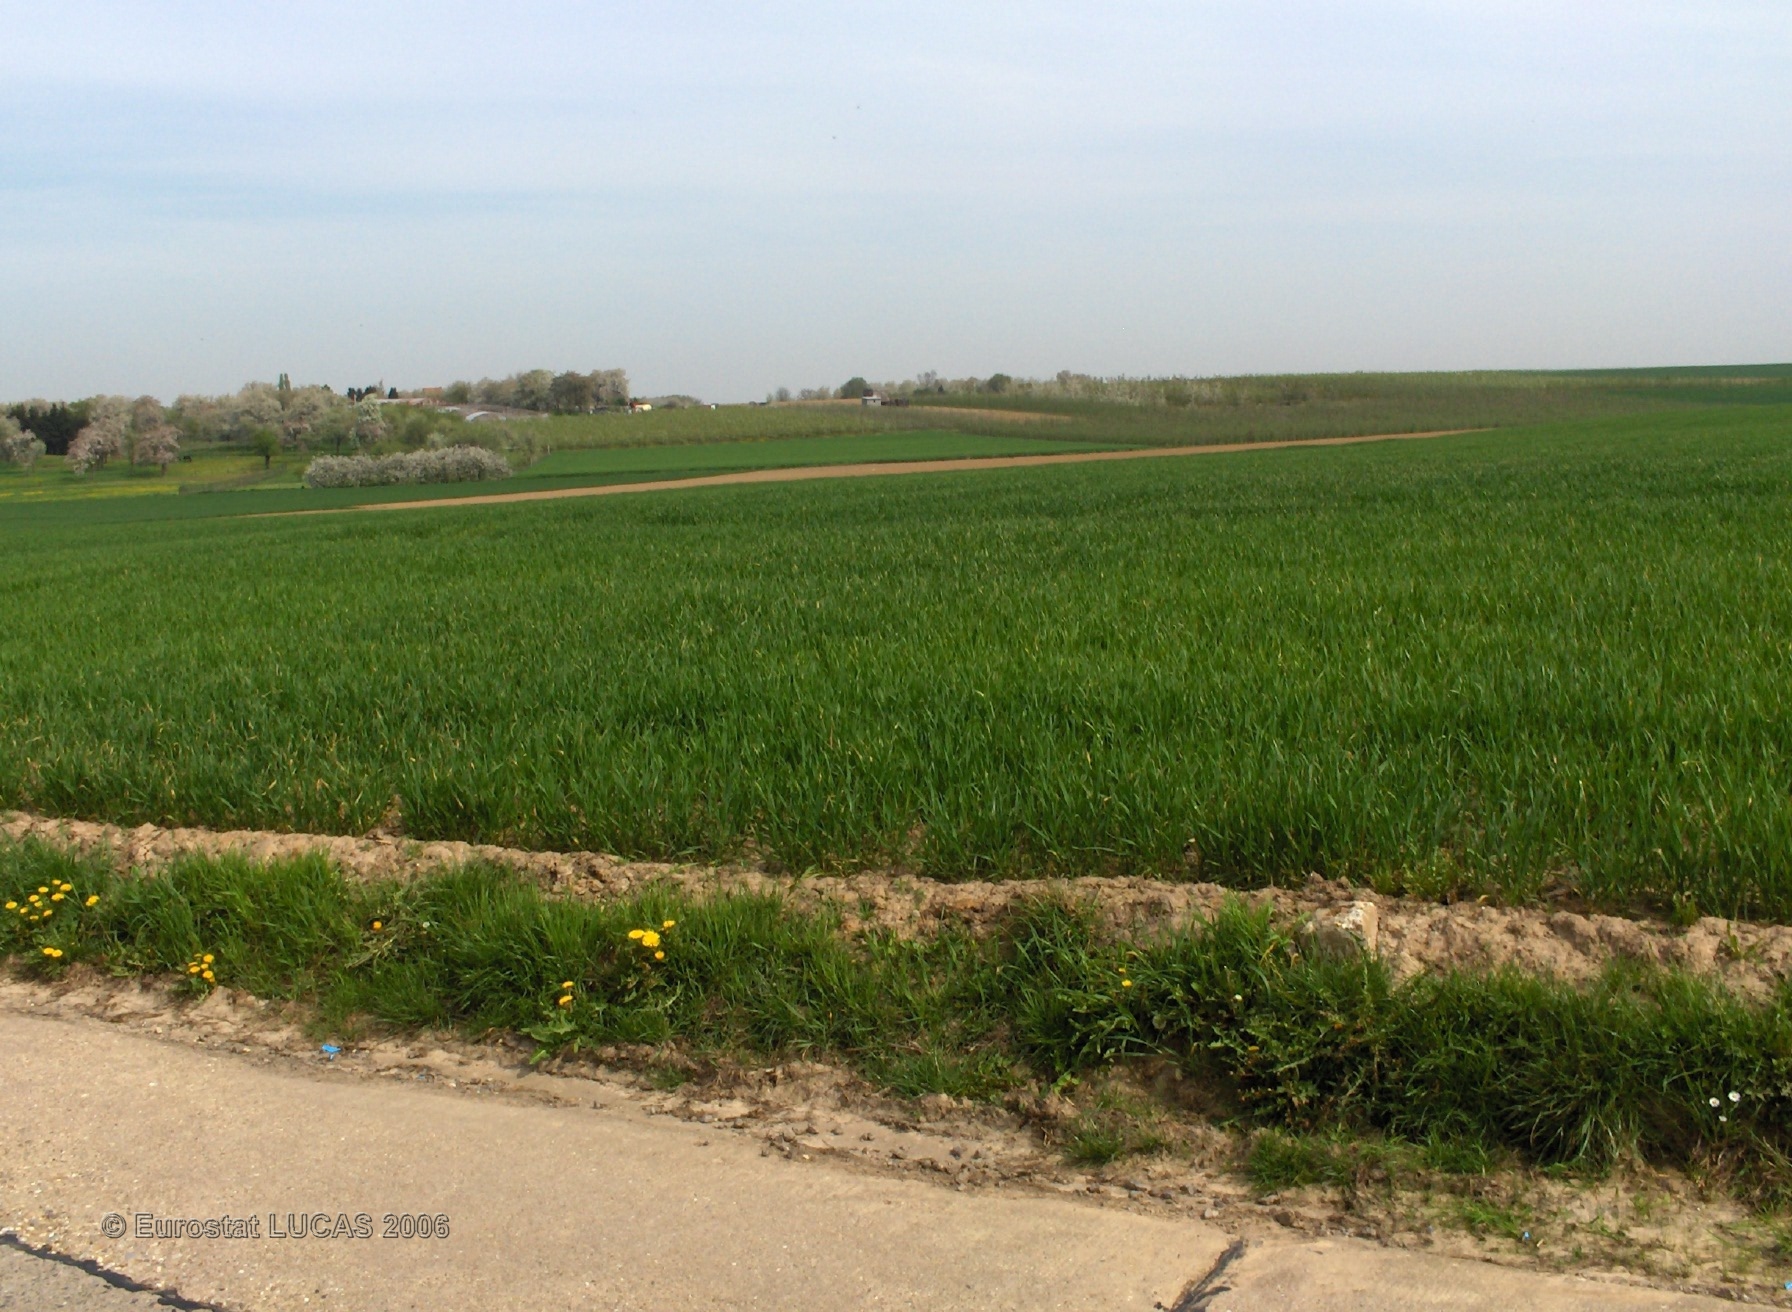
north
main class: Cropland
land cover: Dry pulses
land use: Agriculture (excluding fallow land and kitchen gardens)
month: May
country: BE
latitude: 50.7506
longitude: 5.2211
